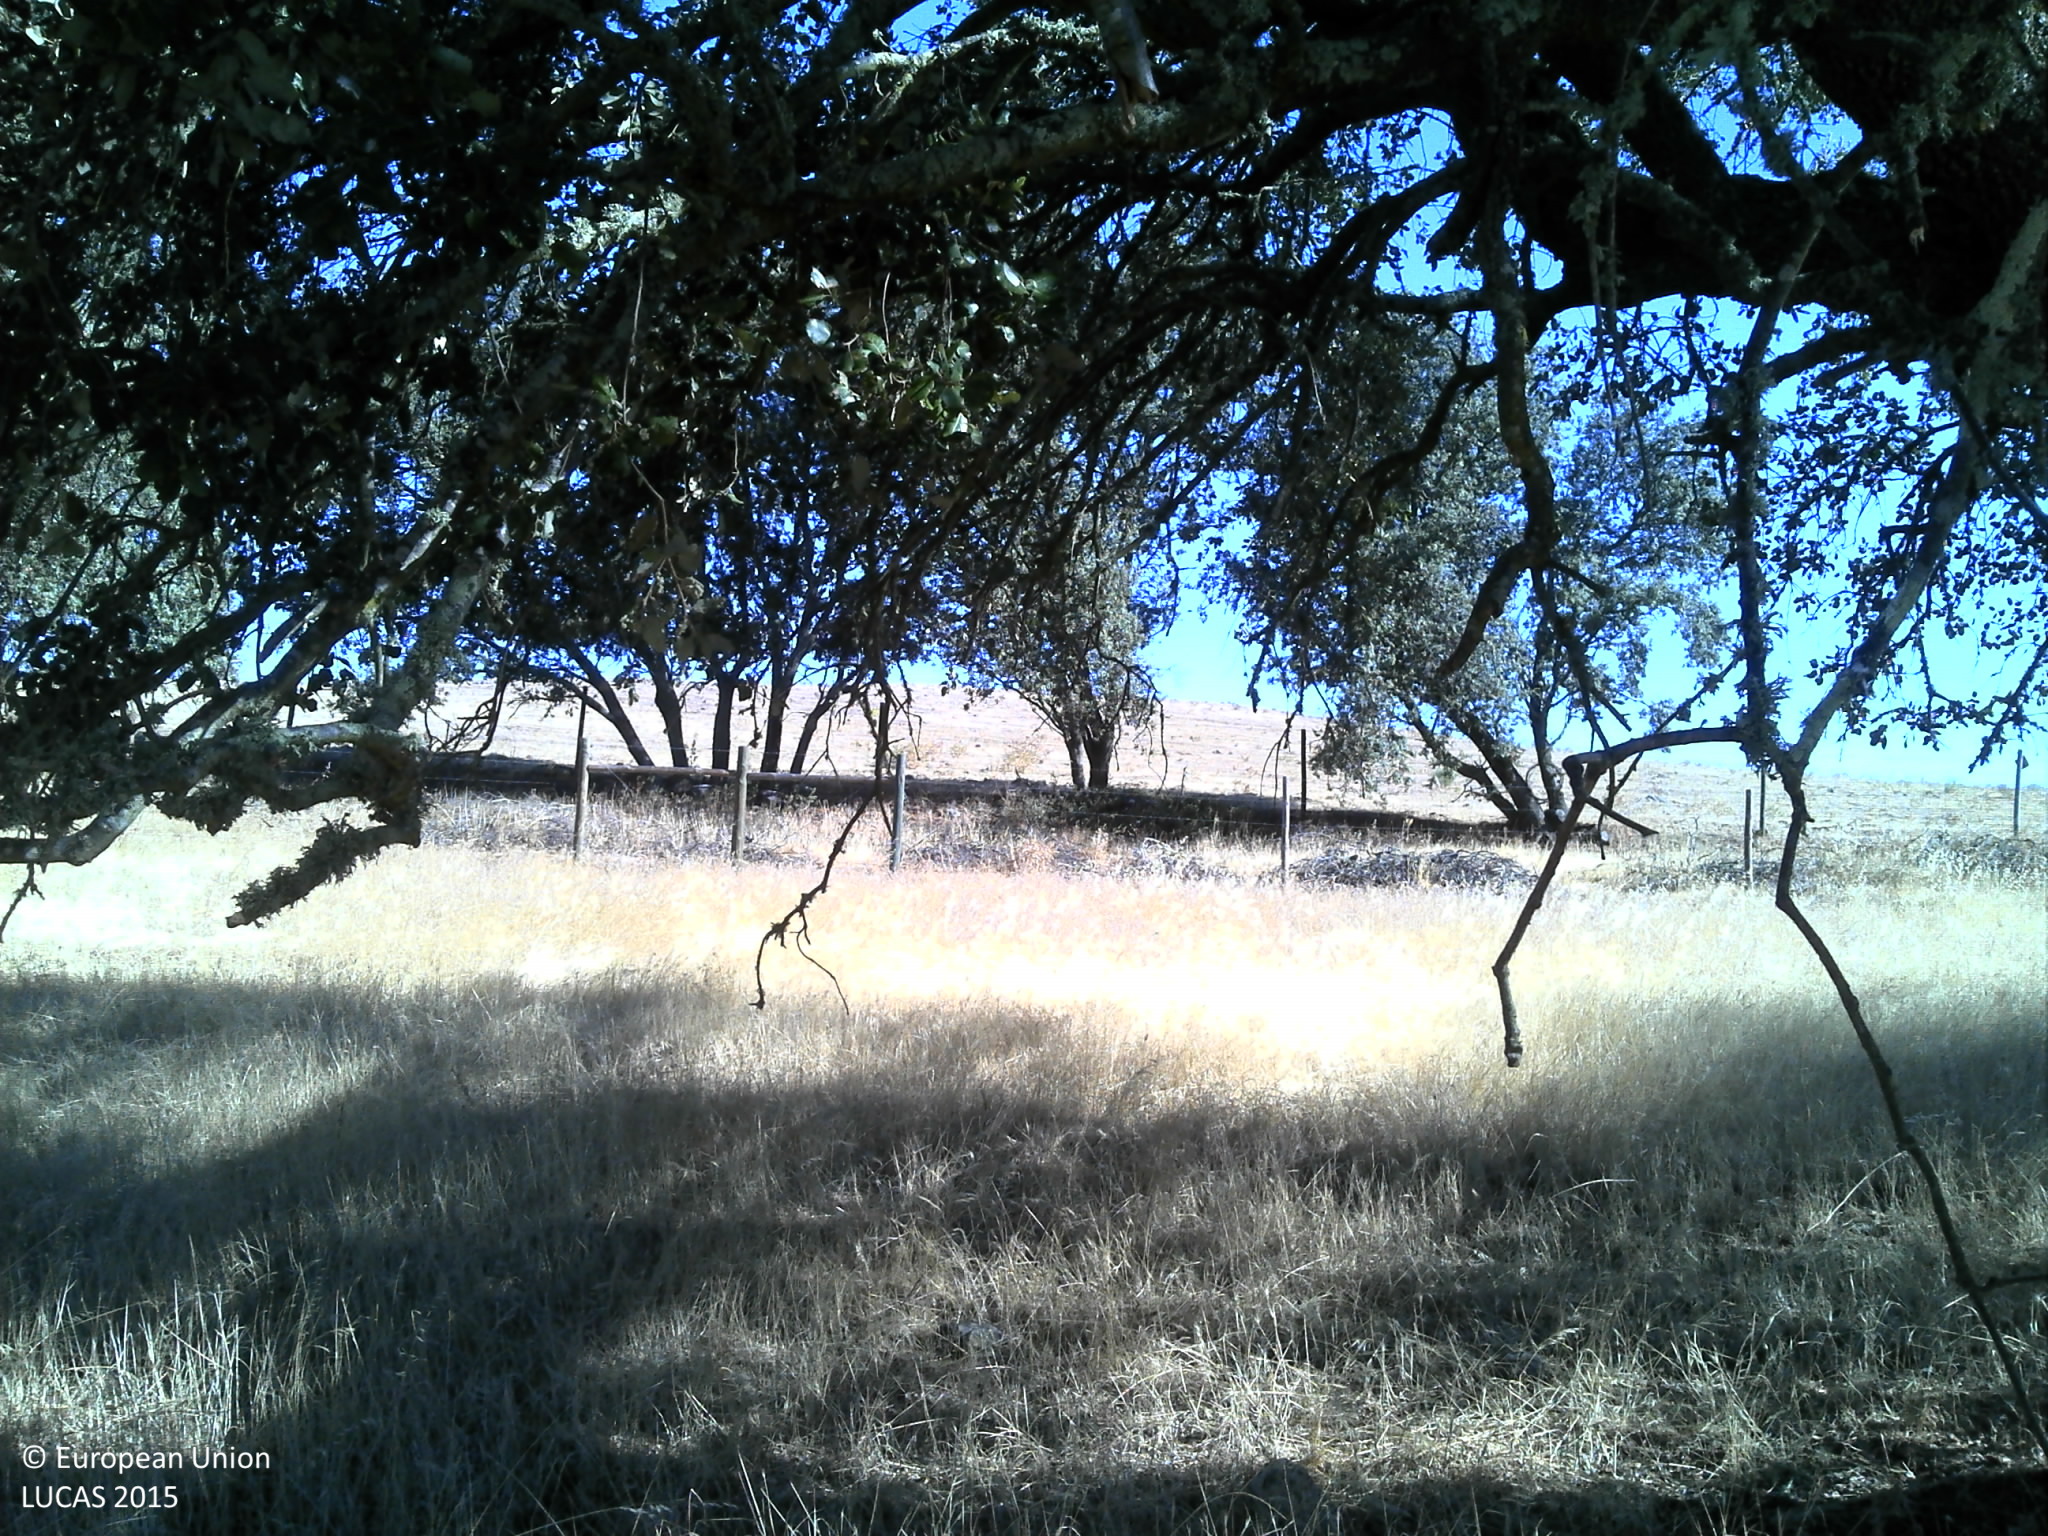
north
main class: Woodland
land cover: Broadleaved woodland
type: broadleaved evergreen forest
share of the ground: 10 - 25 %
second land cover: Grassland without tree/shrub cover
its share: 50 - 75 %
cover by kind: herbaceous plants 60 %, unconsolidated bare surface 25 %, broadleaved forest trees 15 %
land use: Forestry
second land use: Agriculture (excluding fallow land and kitchen gardens)
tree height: > 5 m
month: July
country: PT
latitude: 38.9612
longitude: -7.3795
